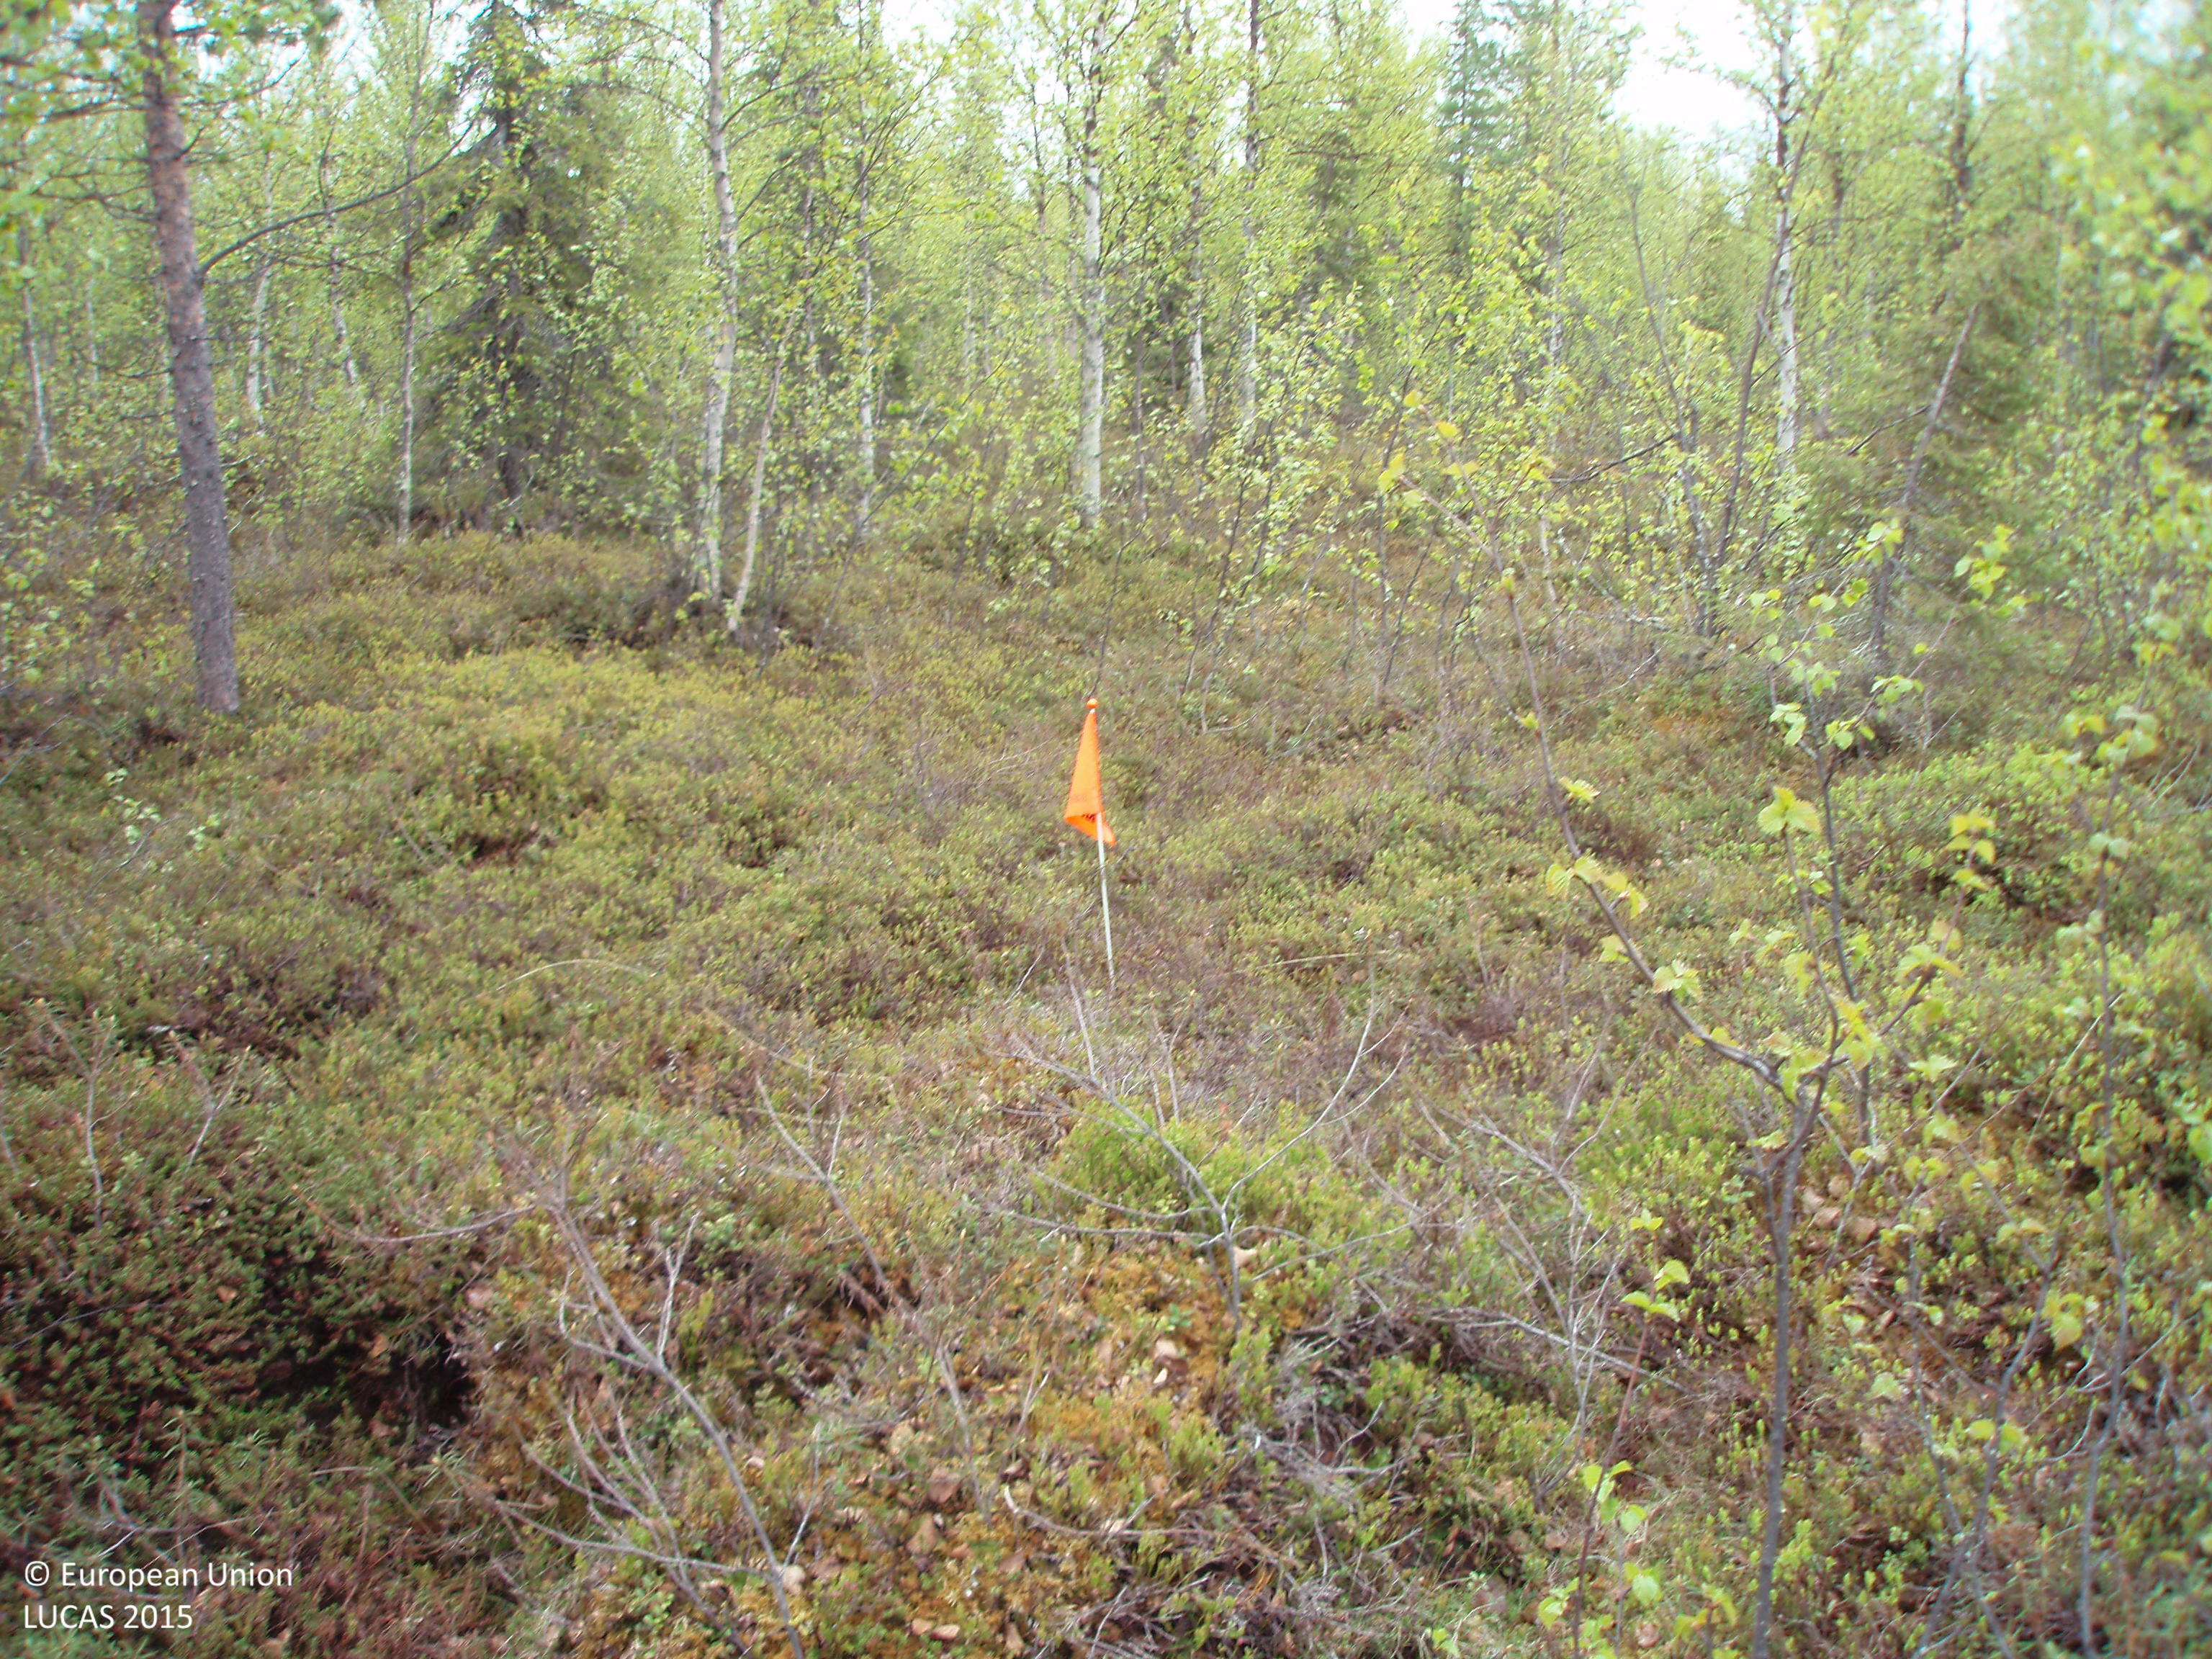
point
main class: Woodland
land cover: Other mixed woodland
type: boreal forest
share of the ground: 50 - 75 %
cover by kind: broadleaved forest trees 50 %, shrubs 30 %, coniferous forest trees 20 %
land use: Forestry
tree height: > 5 m
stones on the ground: 10 - 25 %
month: June
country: FI
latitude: 67.9230
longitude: 26.5887
